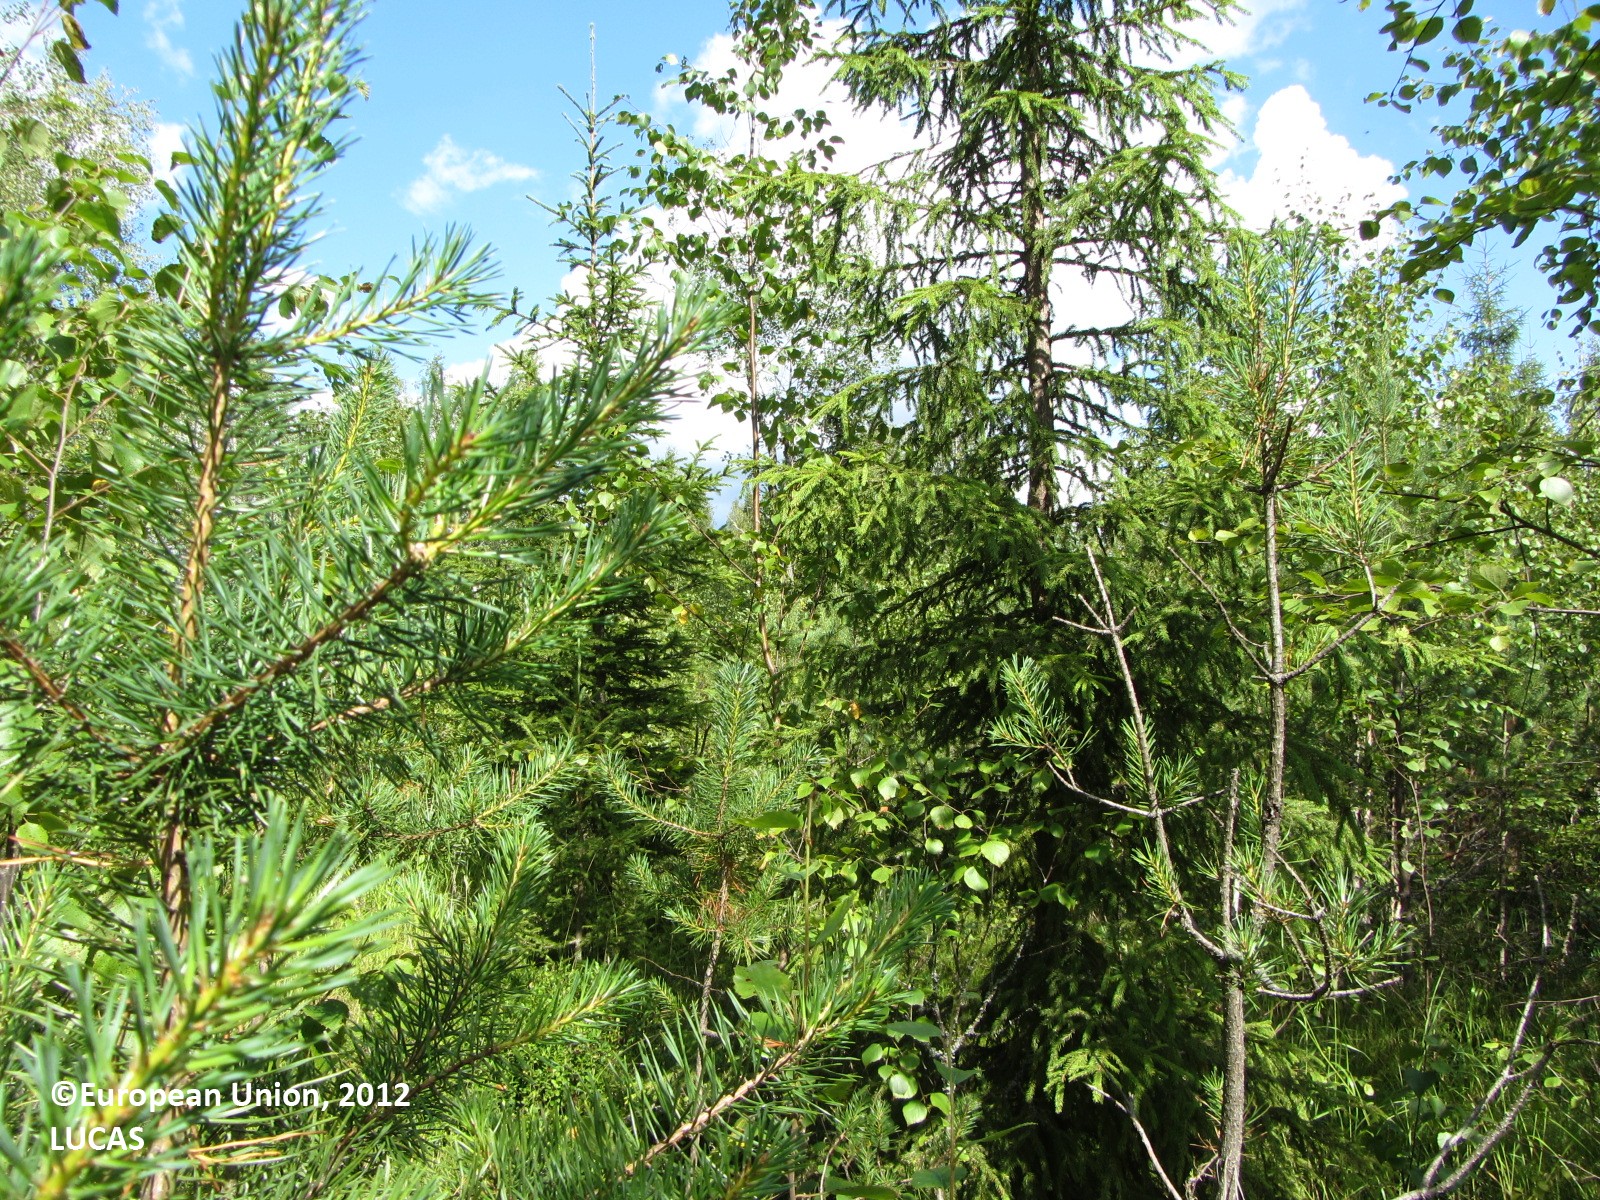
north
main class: Woodland
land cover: Other mixed woodland
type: boreal forest
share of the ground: 50 - 75 %
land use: Forestry
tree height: > 5 m
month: July
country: FI
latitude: 63.6797
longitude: 24.6148
